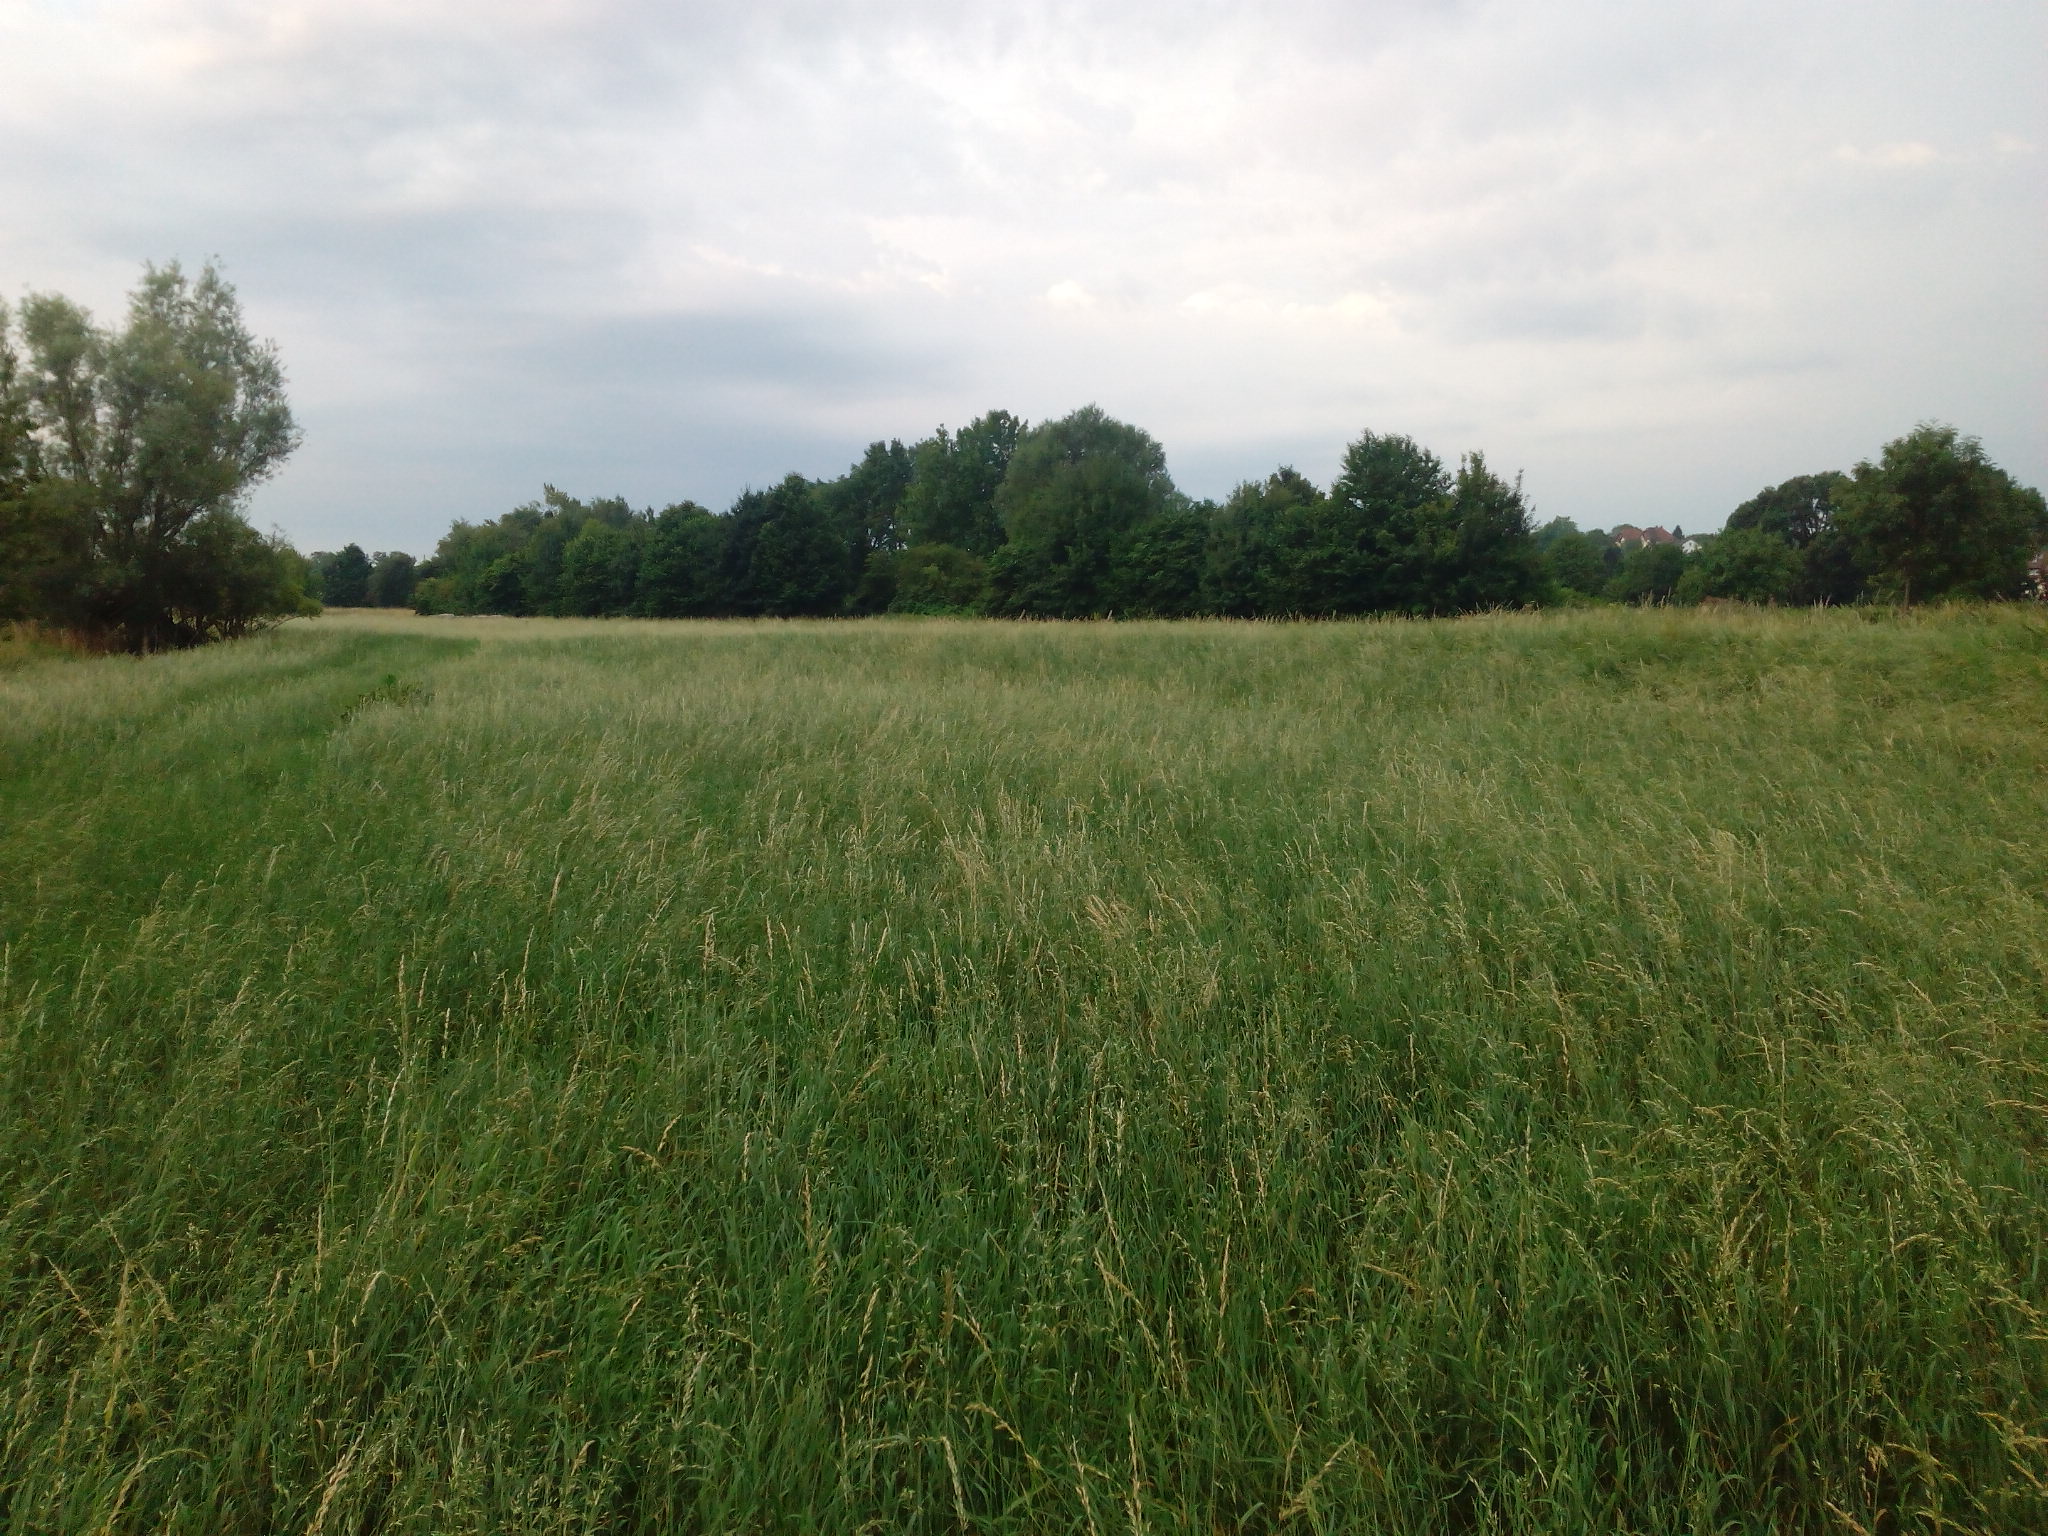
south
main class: Grassland
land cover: Grassland without tree/shrub cover
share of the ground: > 75 %
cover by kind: herbaceous plants 100 %
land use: Agriculture (excluding fallow land and kitchen gardens)
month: August
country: DE
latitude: 52.1617
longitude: 9.9269
